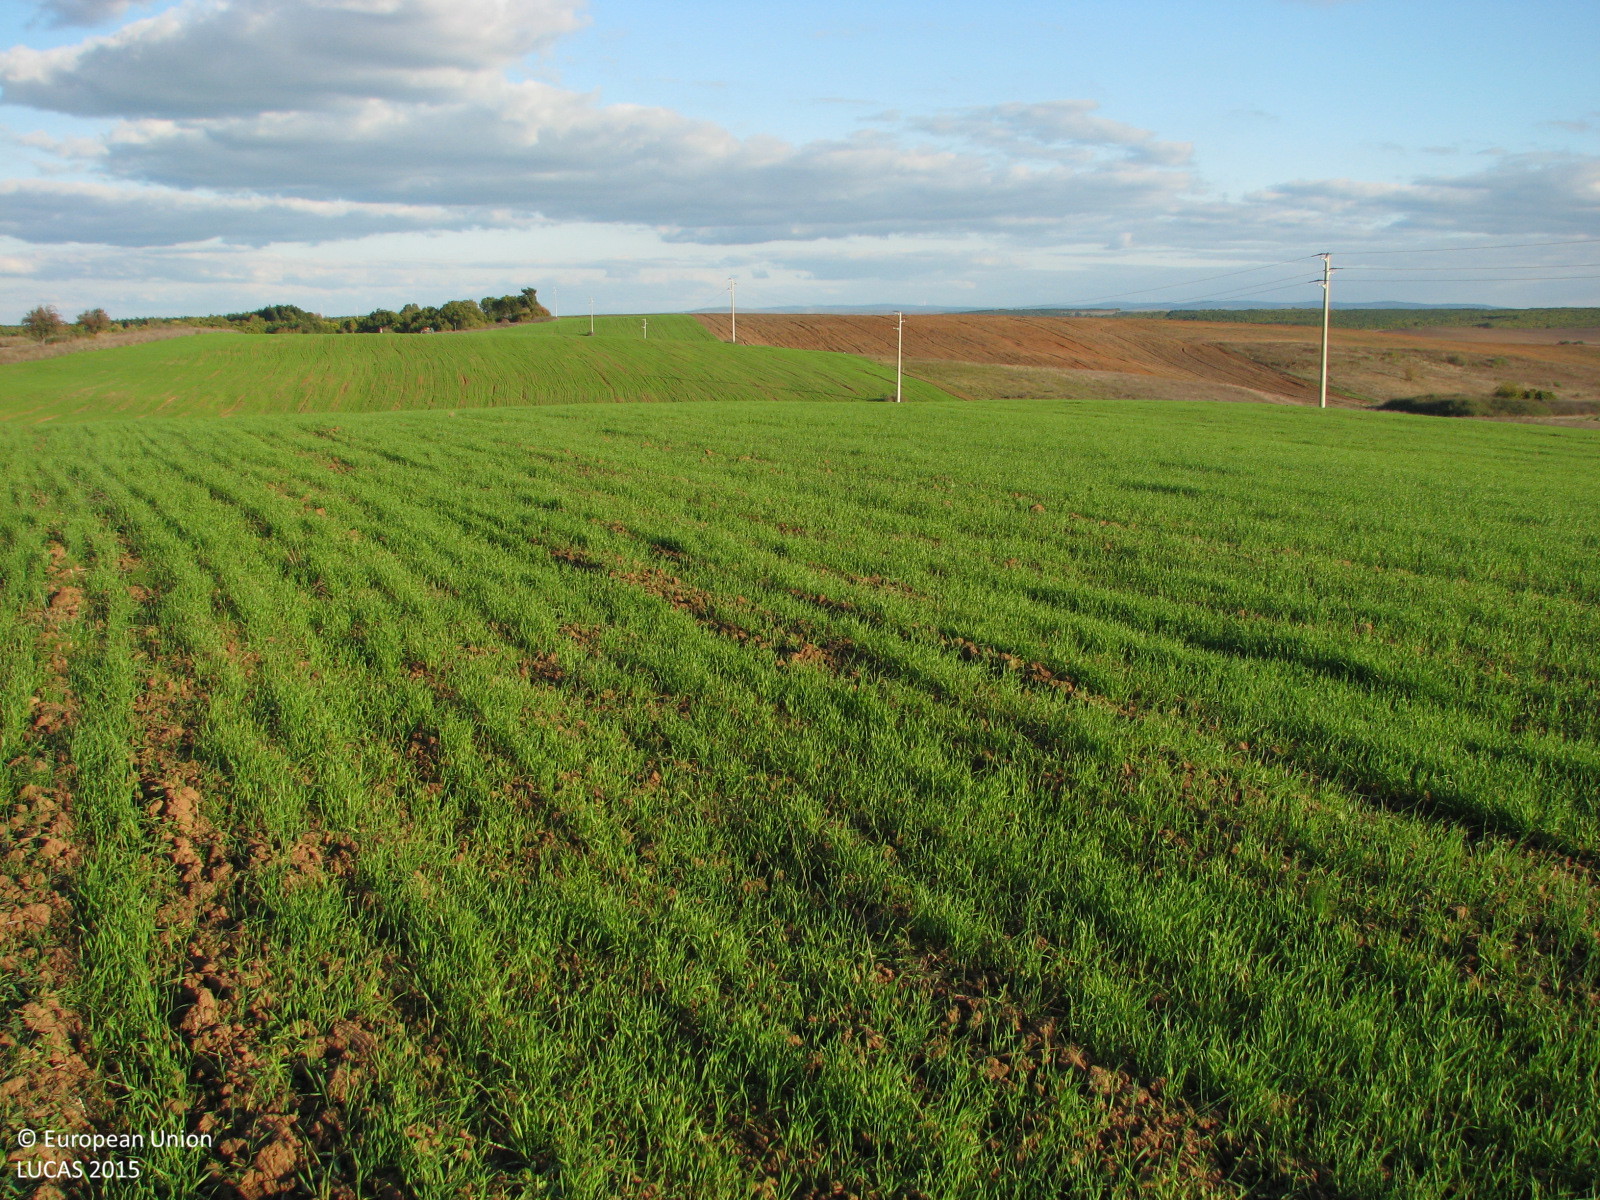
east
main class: Cropland
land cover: Common wheat
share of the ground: 50 - 75 %
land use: Agriculture (excluding fallow land and kitchen gardens)
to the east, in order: Common wheat
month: October
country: BG
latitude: 42.1157
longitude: 26.4007
